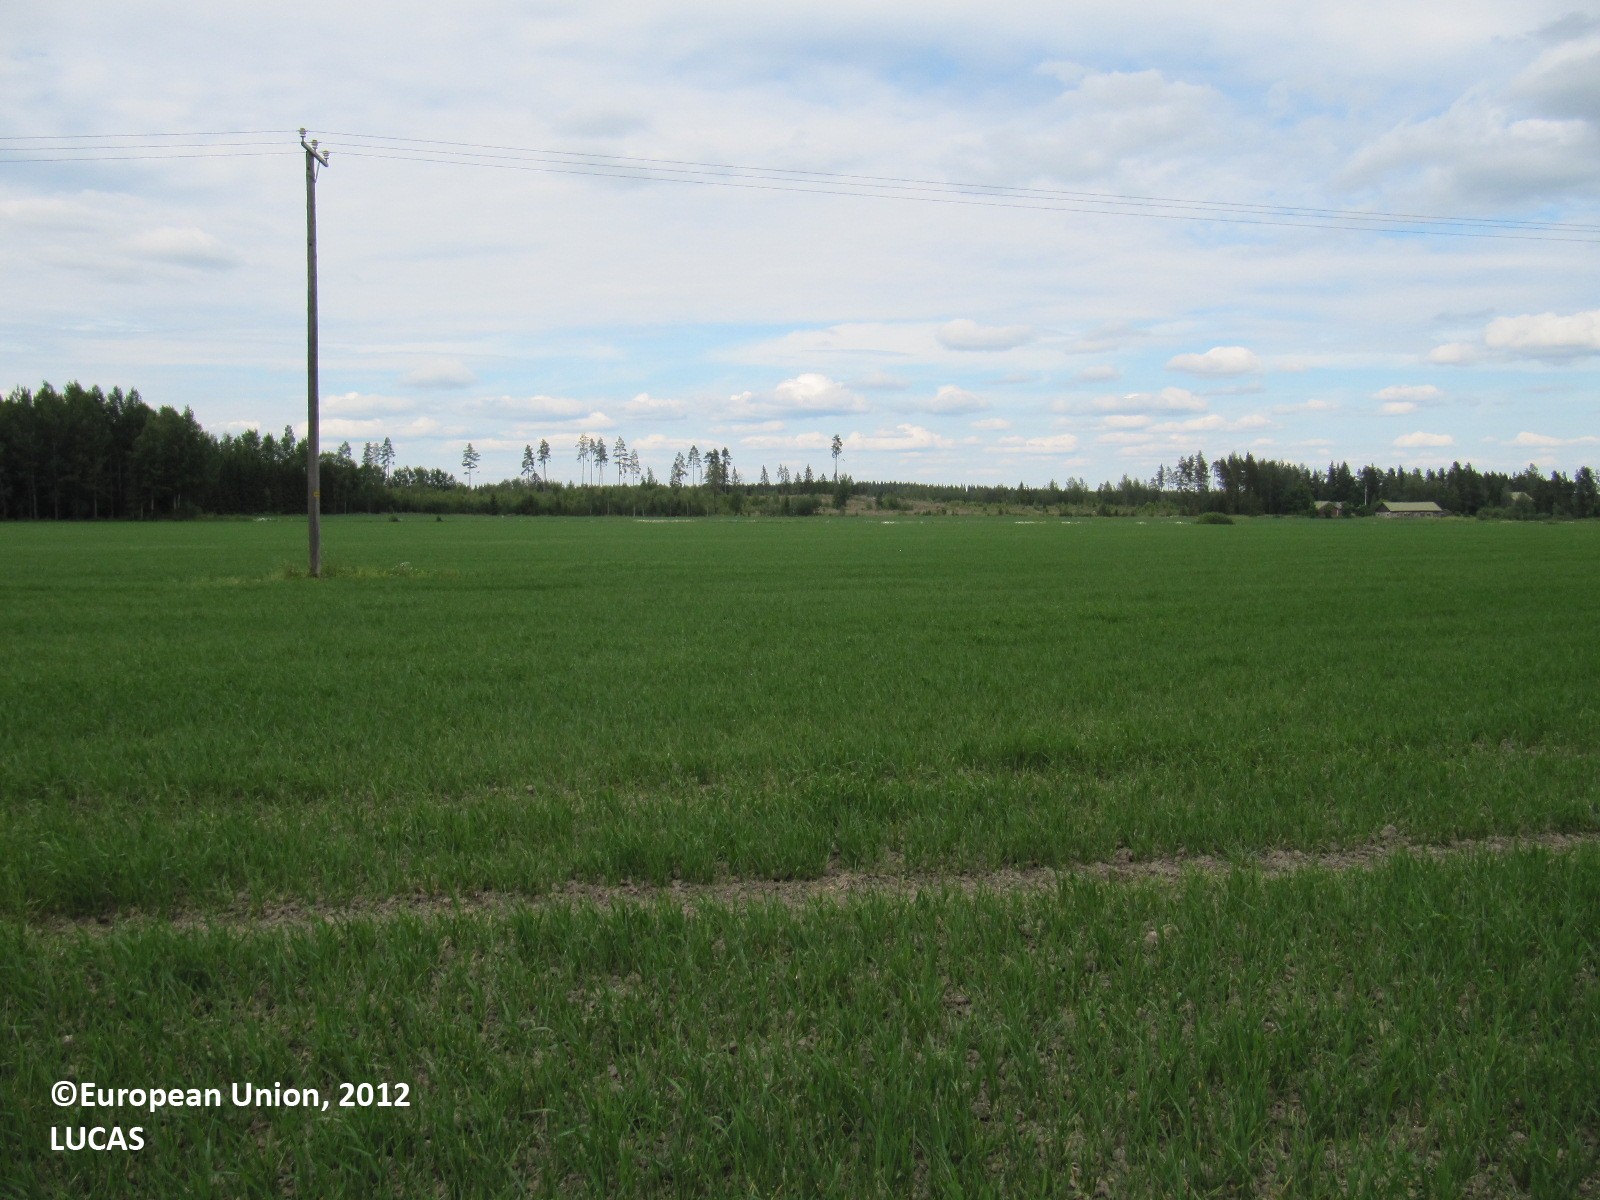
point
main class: Cropland
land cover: Barley
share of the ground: > 75 %
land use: Agriculture (excluding fallow land and kitchen gardens)
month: July
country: FI
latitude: 60.8562
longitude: 23.3911
